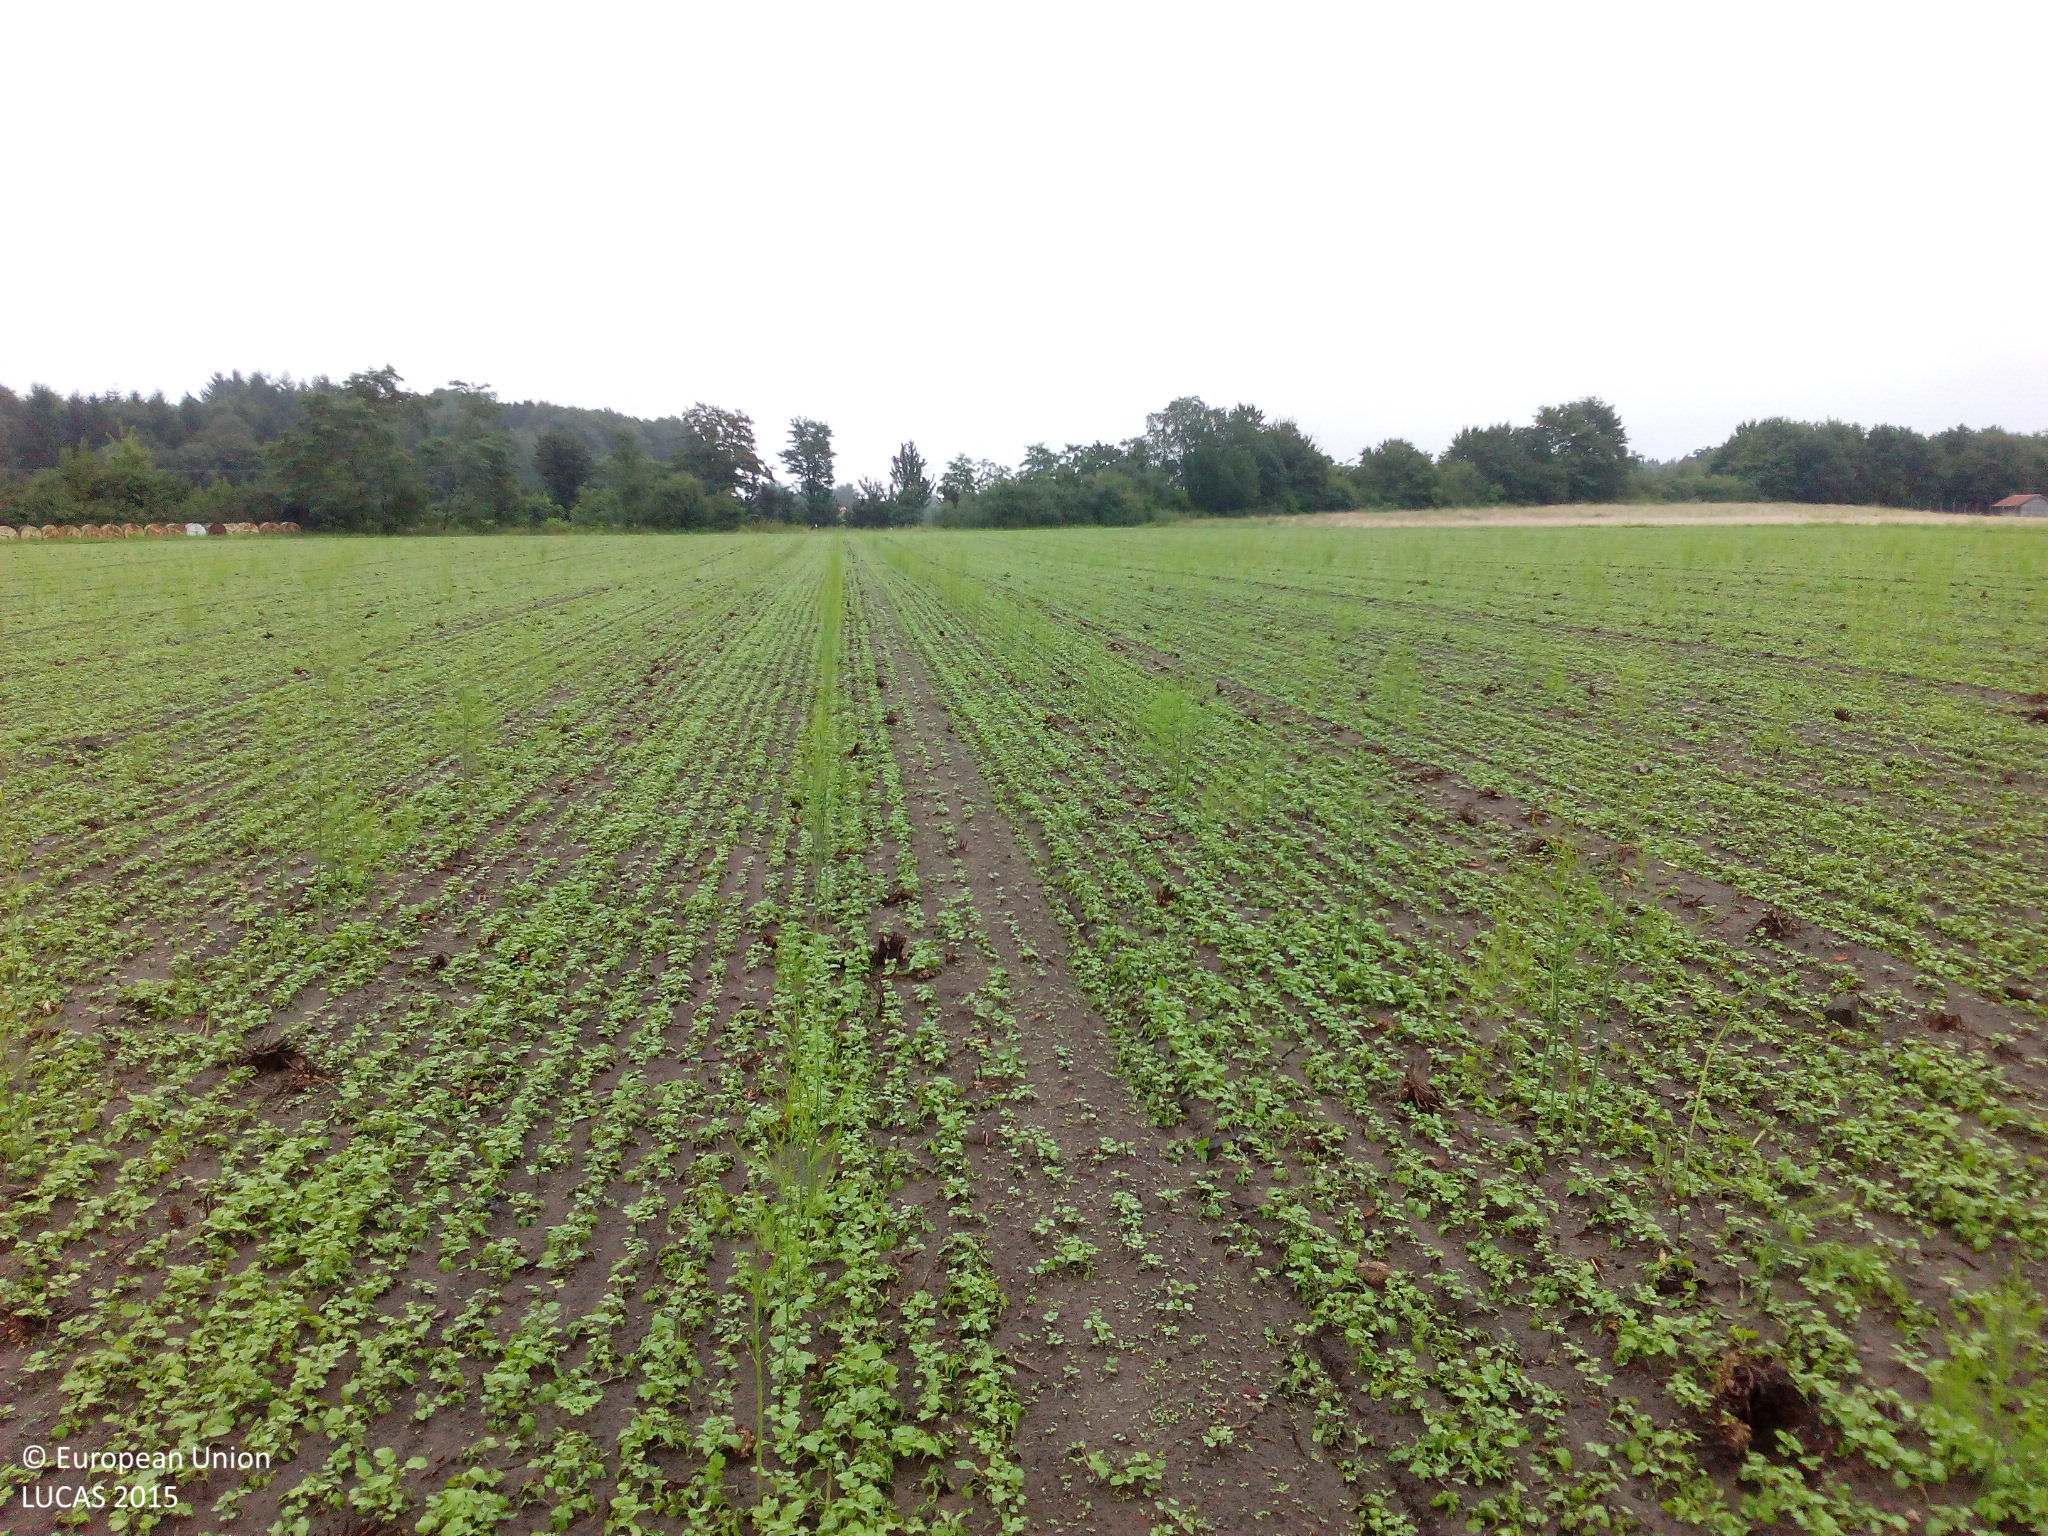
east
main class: Cropland
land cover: Other fresh vegetables
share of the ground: 10 - 25 %
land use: Agriculture (excluding fallow land and kitchen gardens)
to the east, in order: Other fresh vegetables; Grass margins; Tracks; Grassland without tree/shrub cover; Broadleaved woodland; Ditches and canals; Shruby margins; Grass margins; Paved roads, cycling and walking lanes; Grass margins; Broadleaved woodland; Grass margins; Tracks; Shruby margins; Fences; Spontaneously vegetated surfaces; Strawberries
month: August
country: DE
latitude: 52.0555
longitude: 8.0316
